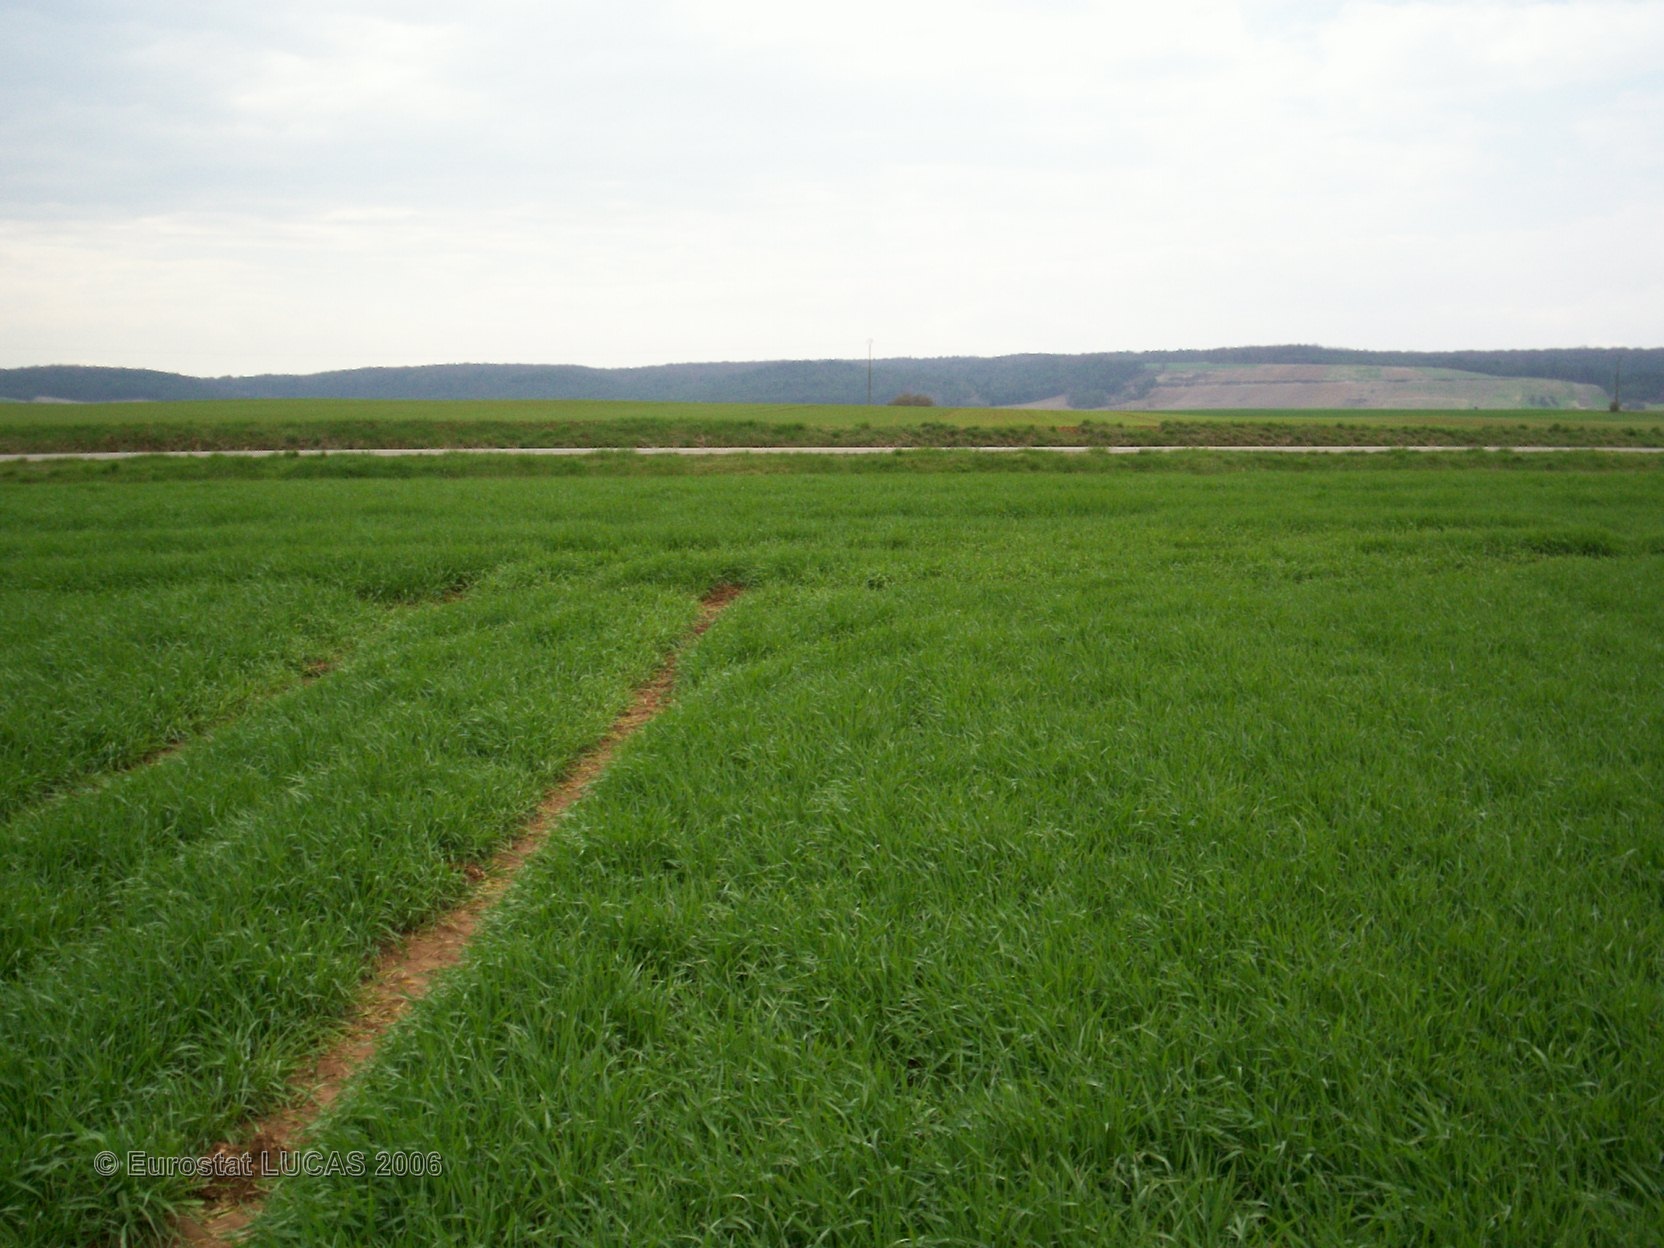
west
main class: Cropland
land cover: Barley
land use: Agriculture (excluding fallow land and kitchen gardens)
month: April
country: FR
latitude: 47.9318
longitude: 4.6580
